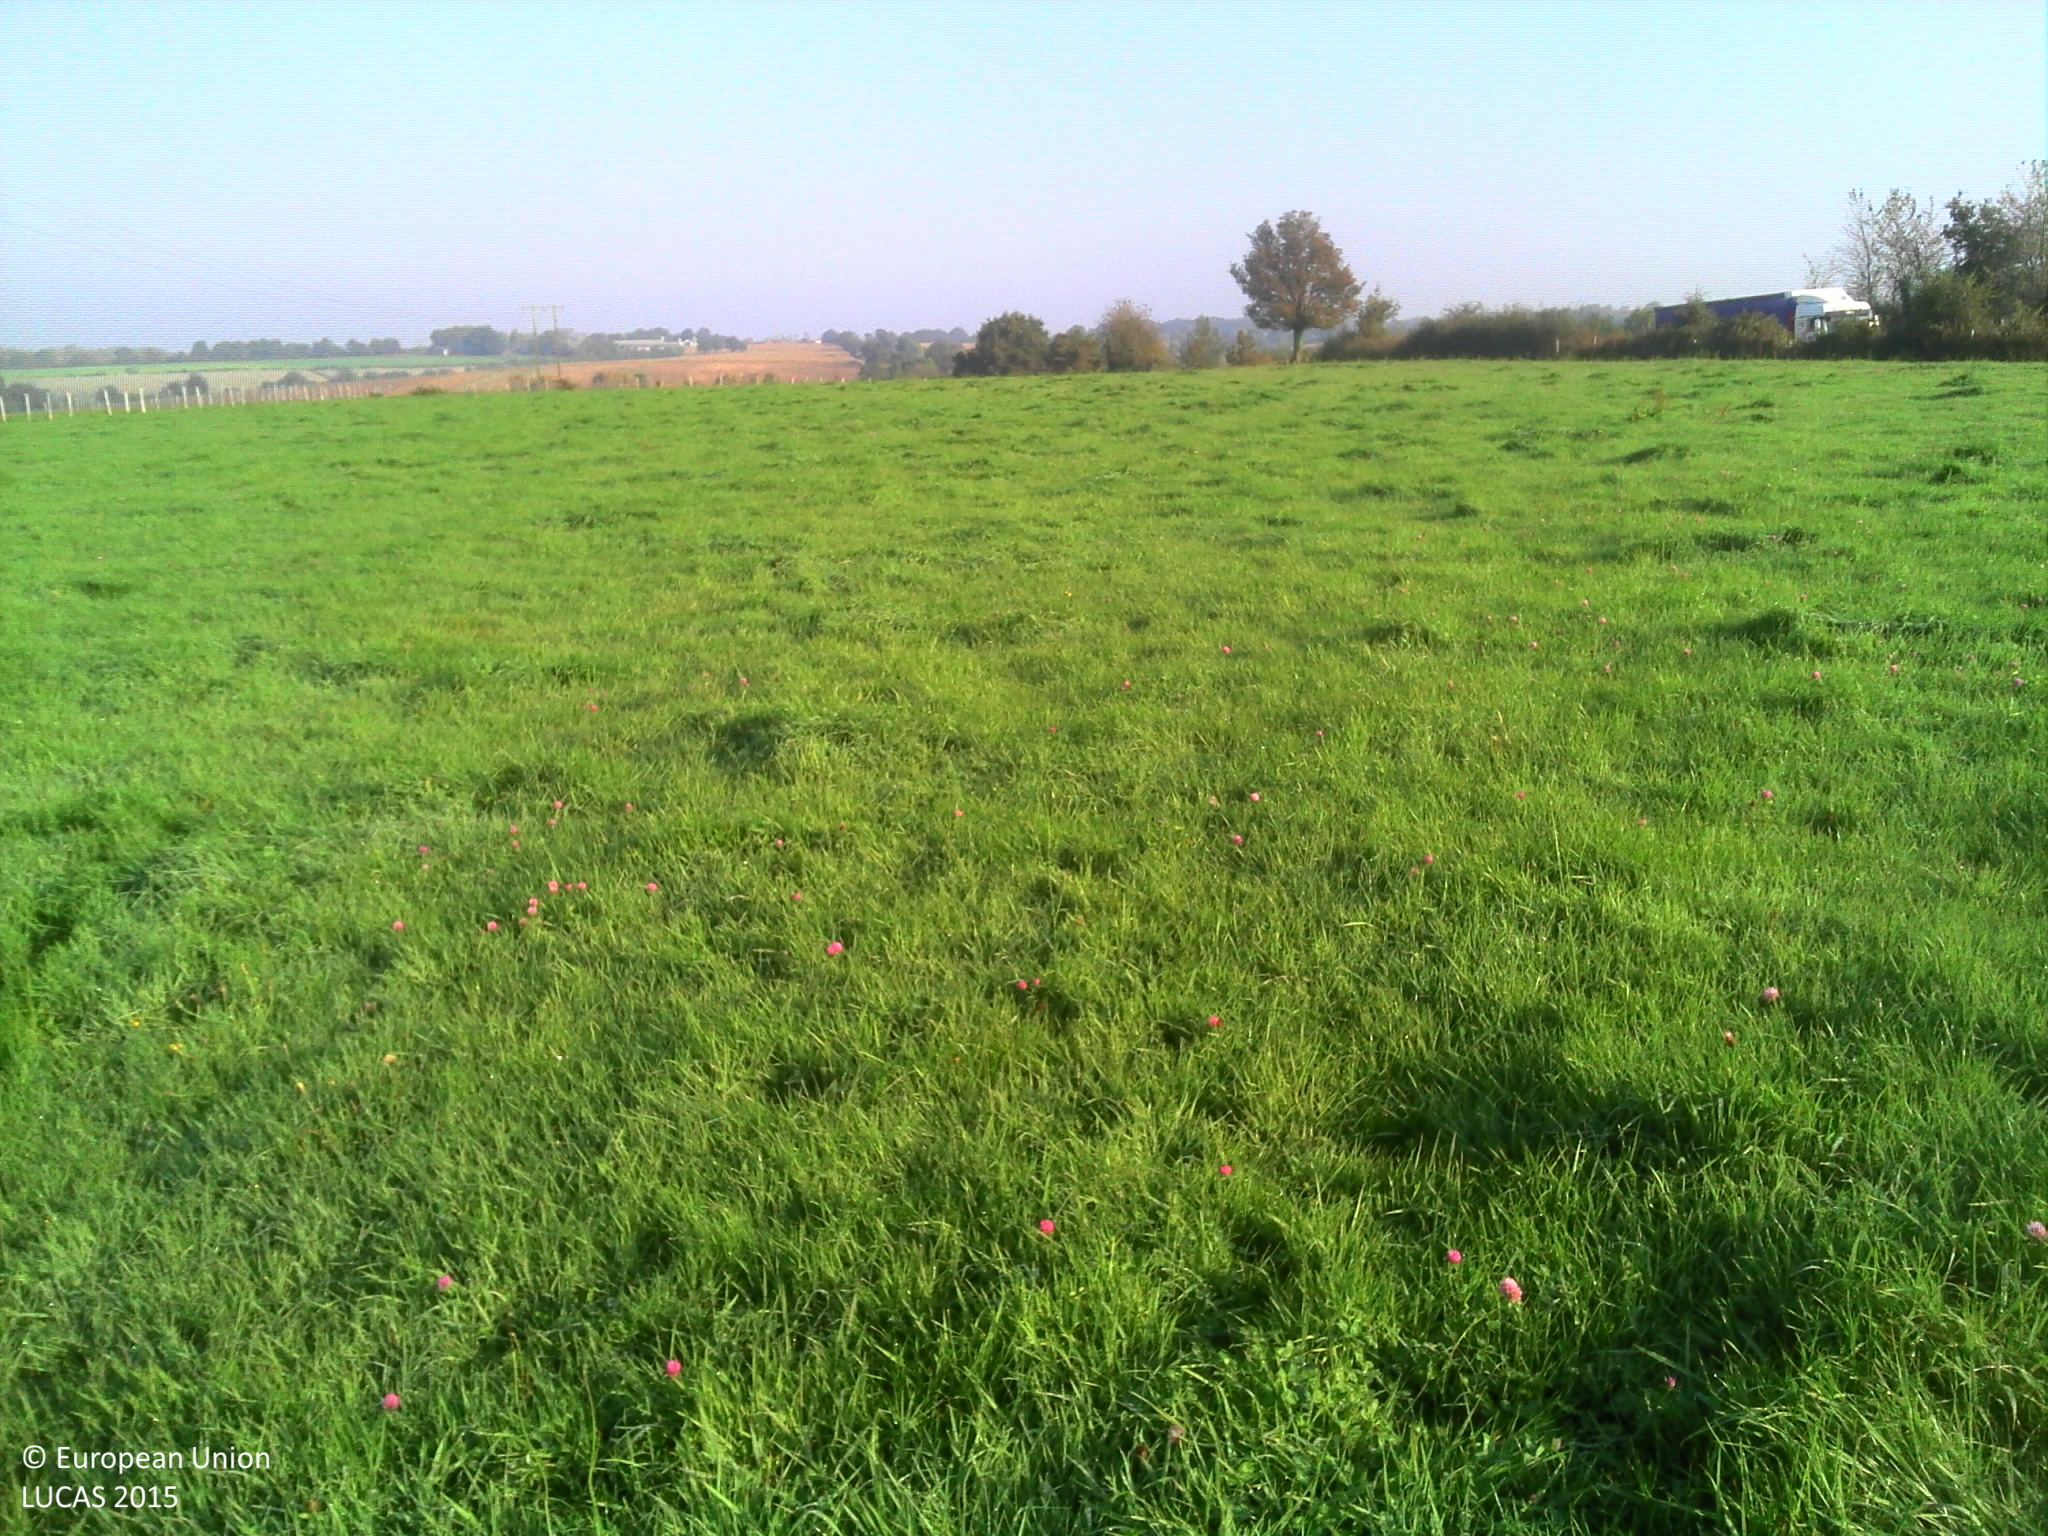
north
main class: Grassland
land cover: Grassland without tree/shrub cover
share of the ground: > 75 %
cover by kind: herbaceous plants 100 %
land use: Agriculture (excluding fallow land and kitchen gardens)
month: October
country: FR
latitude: 46.6137
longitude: -1.0403
